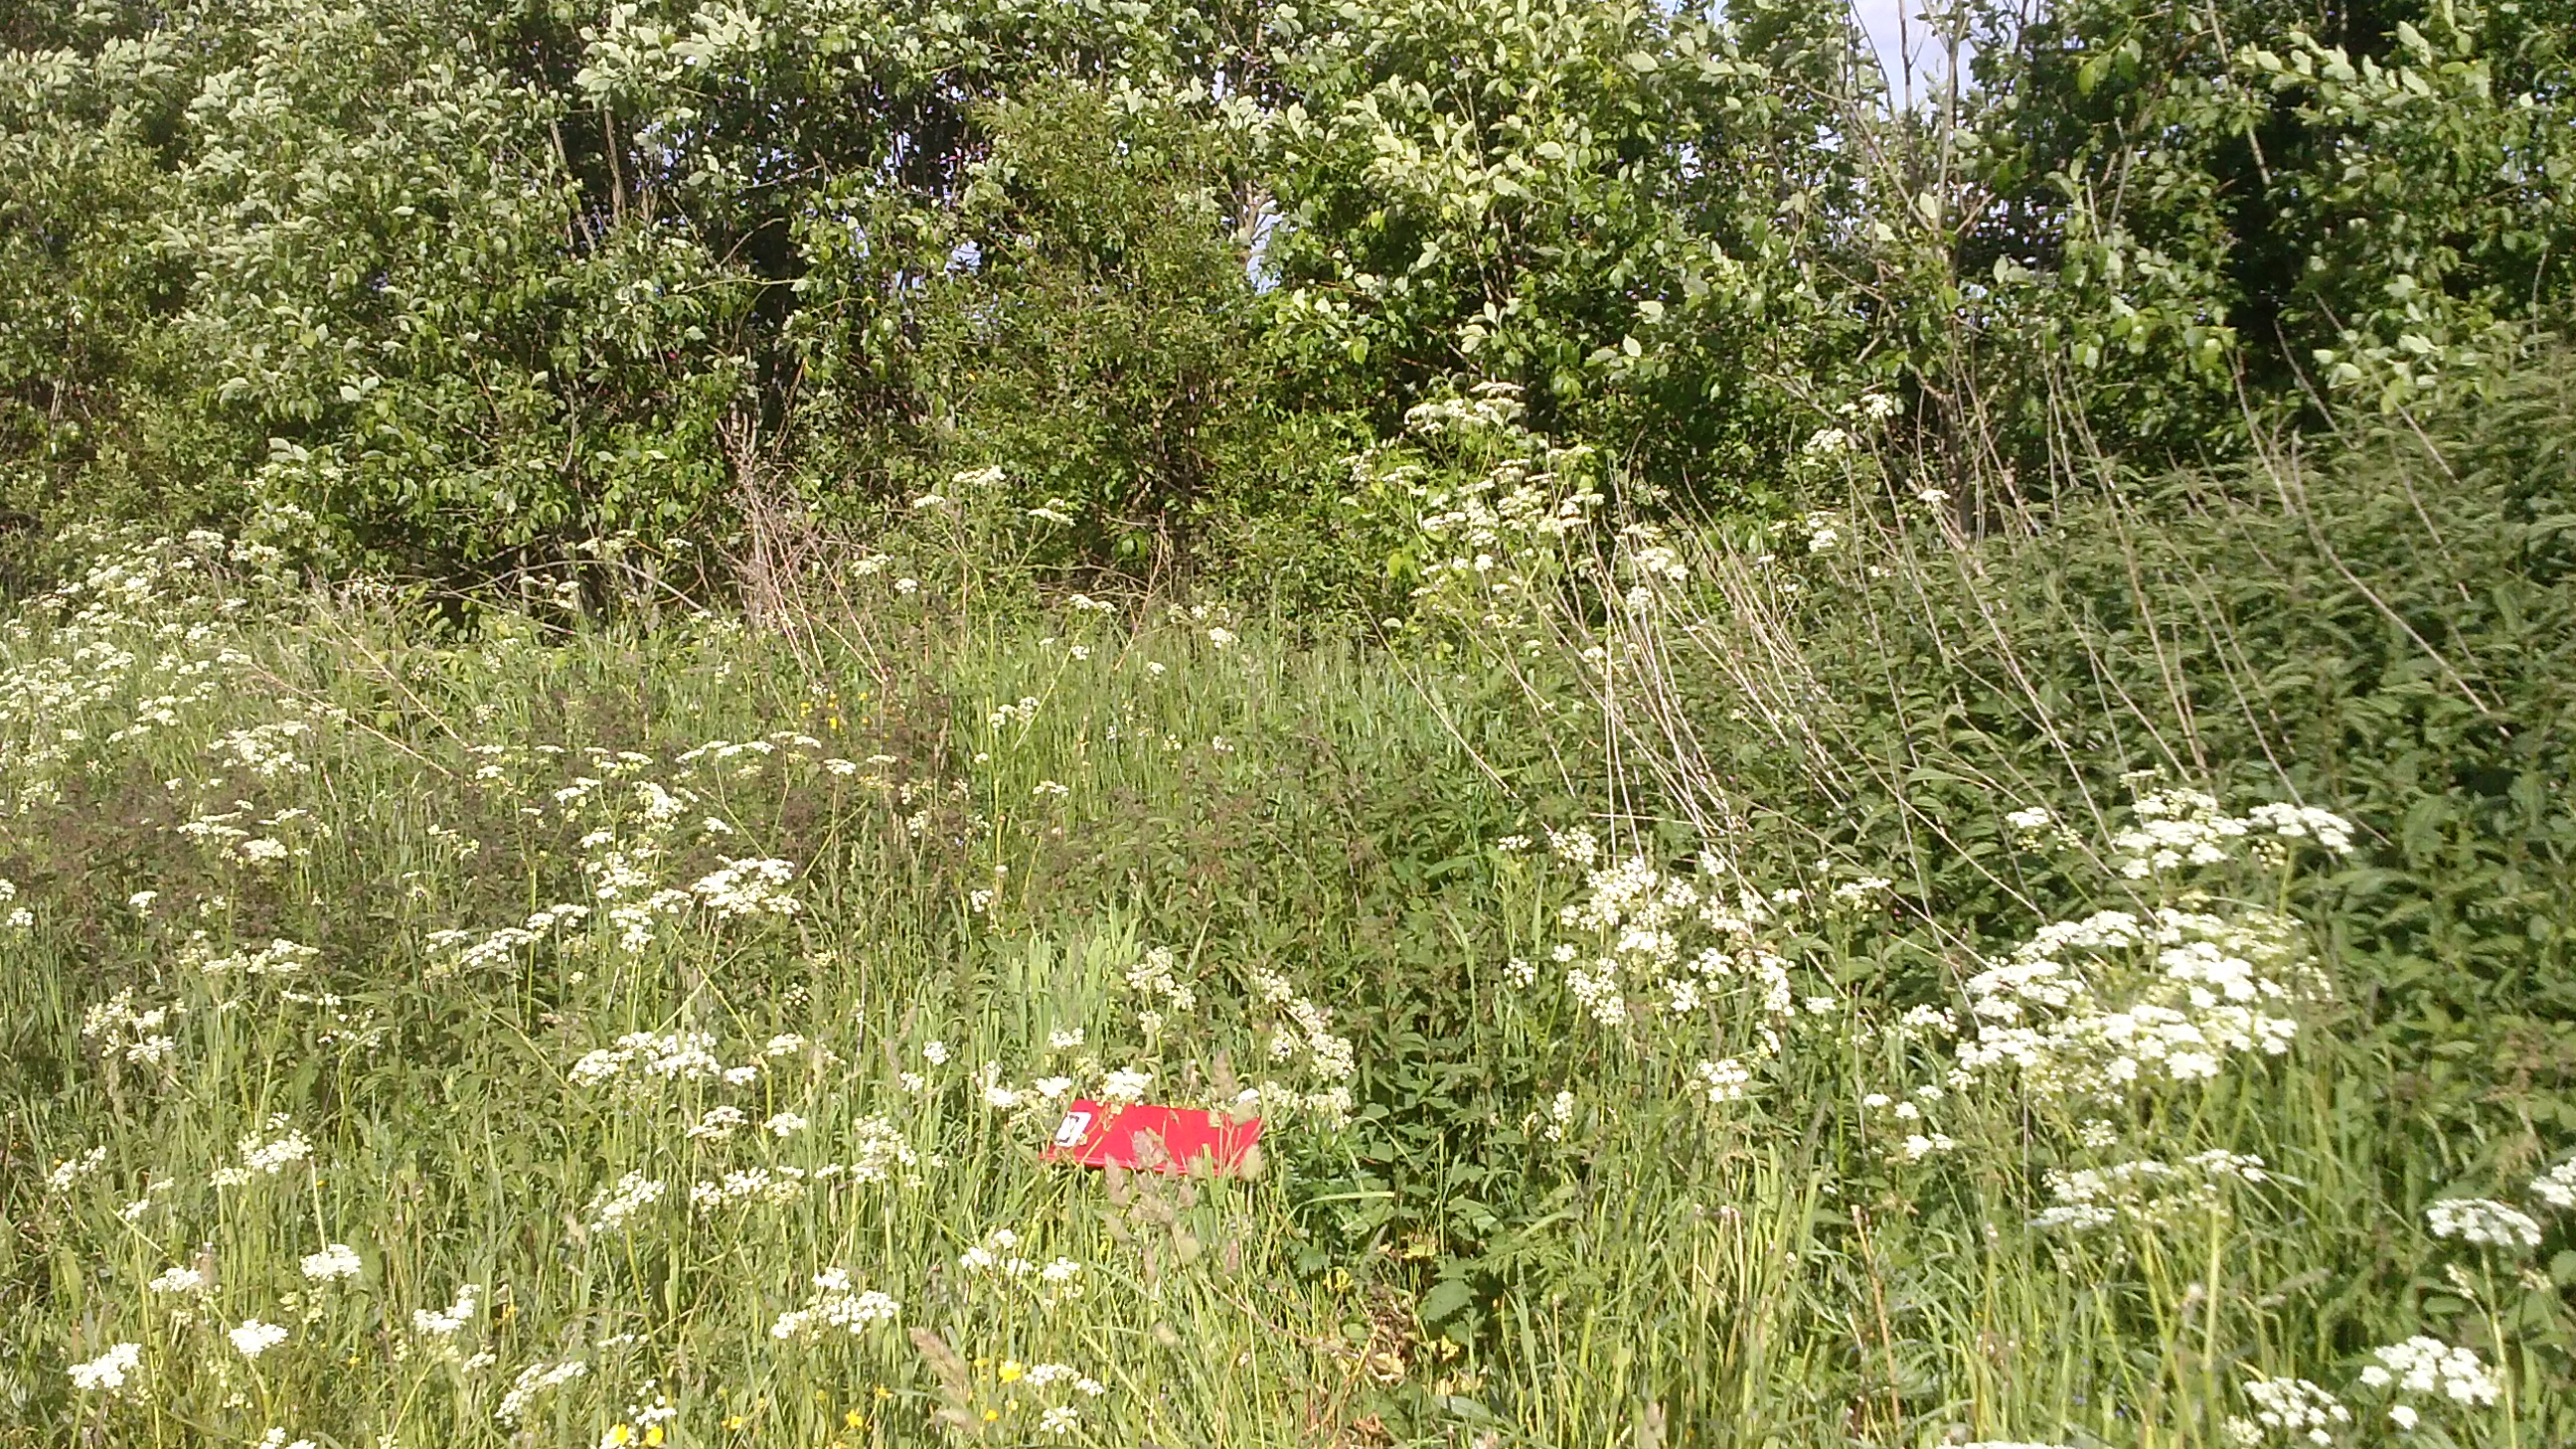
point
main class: Grassland
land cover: Spontaneously vegetated surfaces
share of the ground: > 75 %
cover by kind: herbaceous plants 95 %, shrubs 5 %
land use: Semi-natural and natural areas not in use
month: June
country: LV
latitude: 56.4703
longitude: 27.4660
